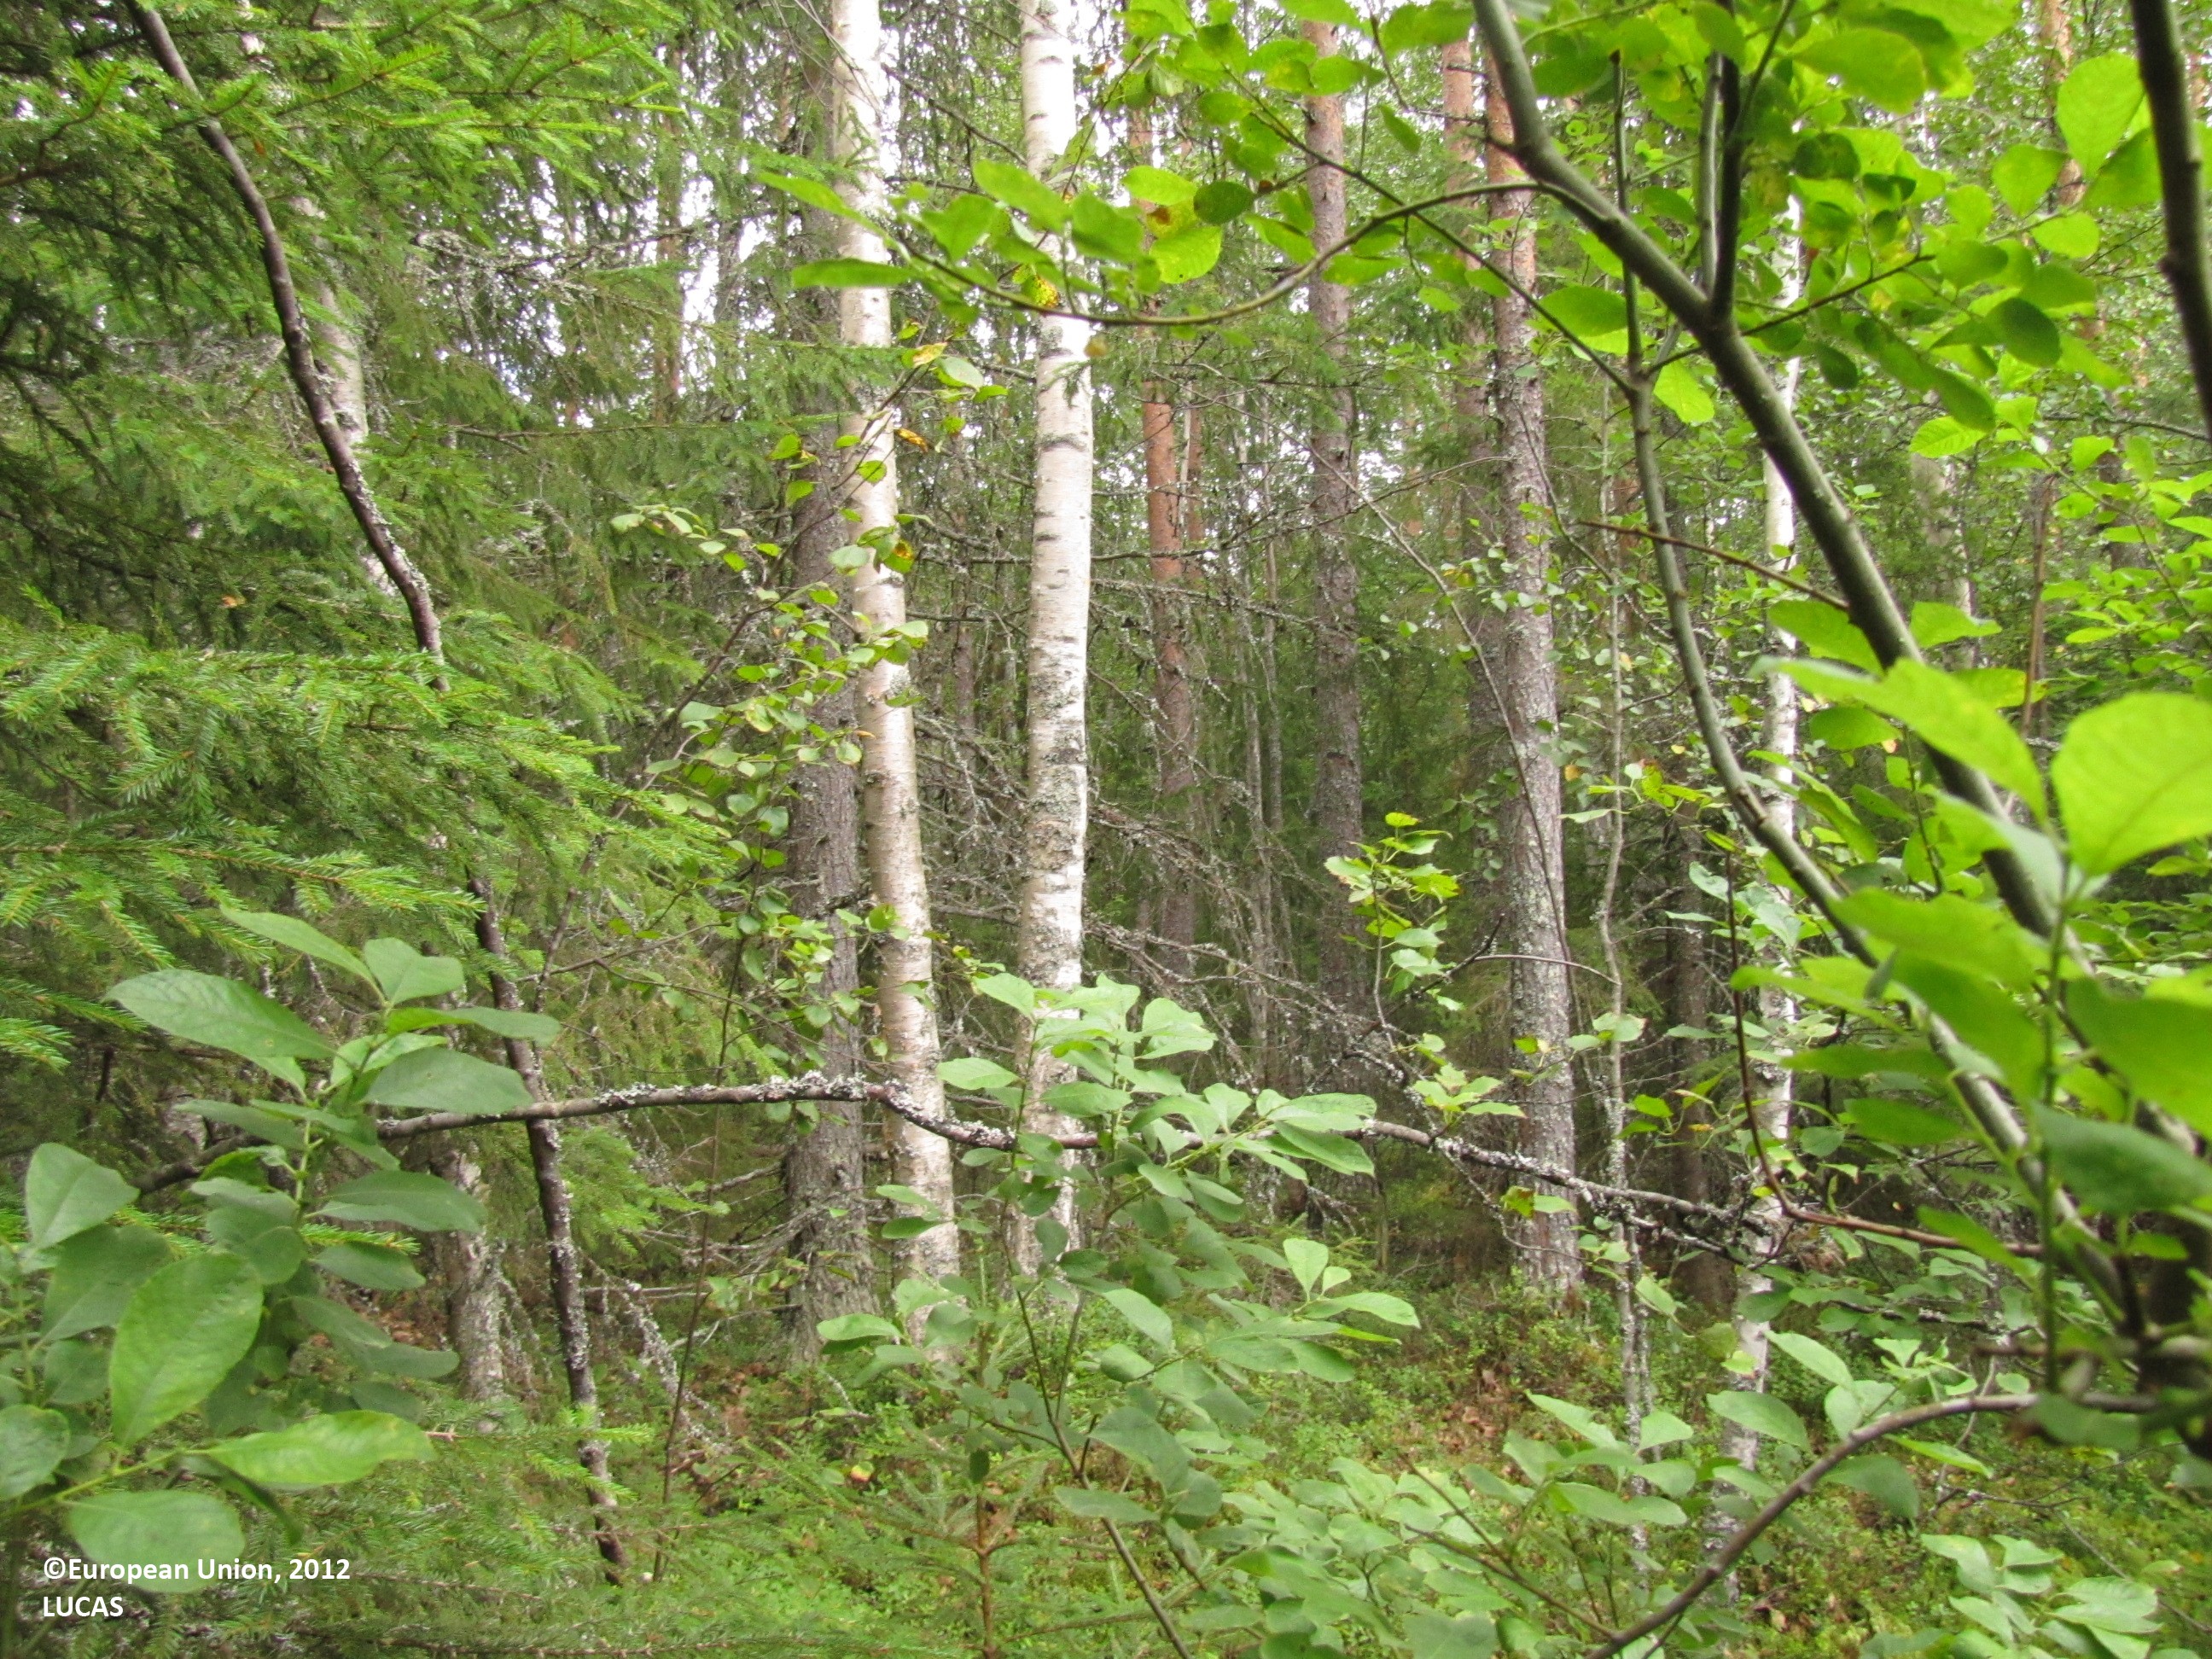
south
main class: Woodland
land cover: Pine dominated mixed woodland
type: boreal forest
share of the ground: 50 - 75 %
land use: Forestry
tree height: > 5 m
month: August
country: FI
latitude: 61.8978
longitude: 23.2213
